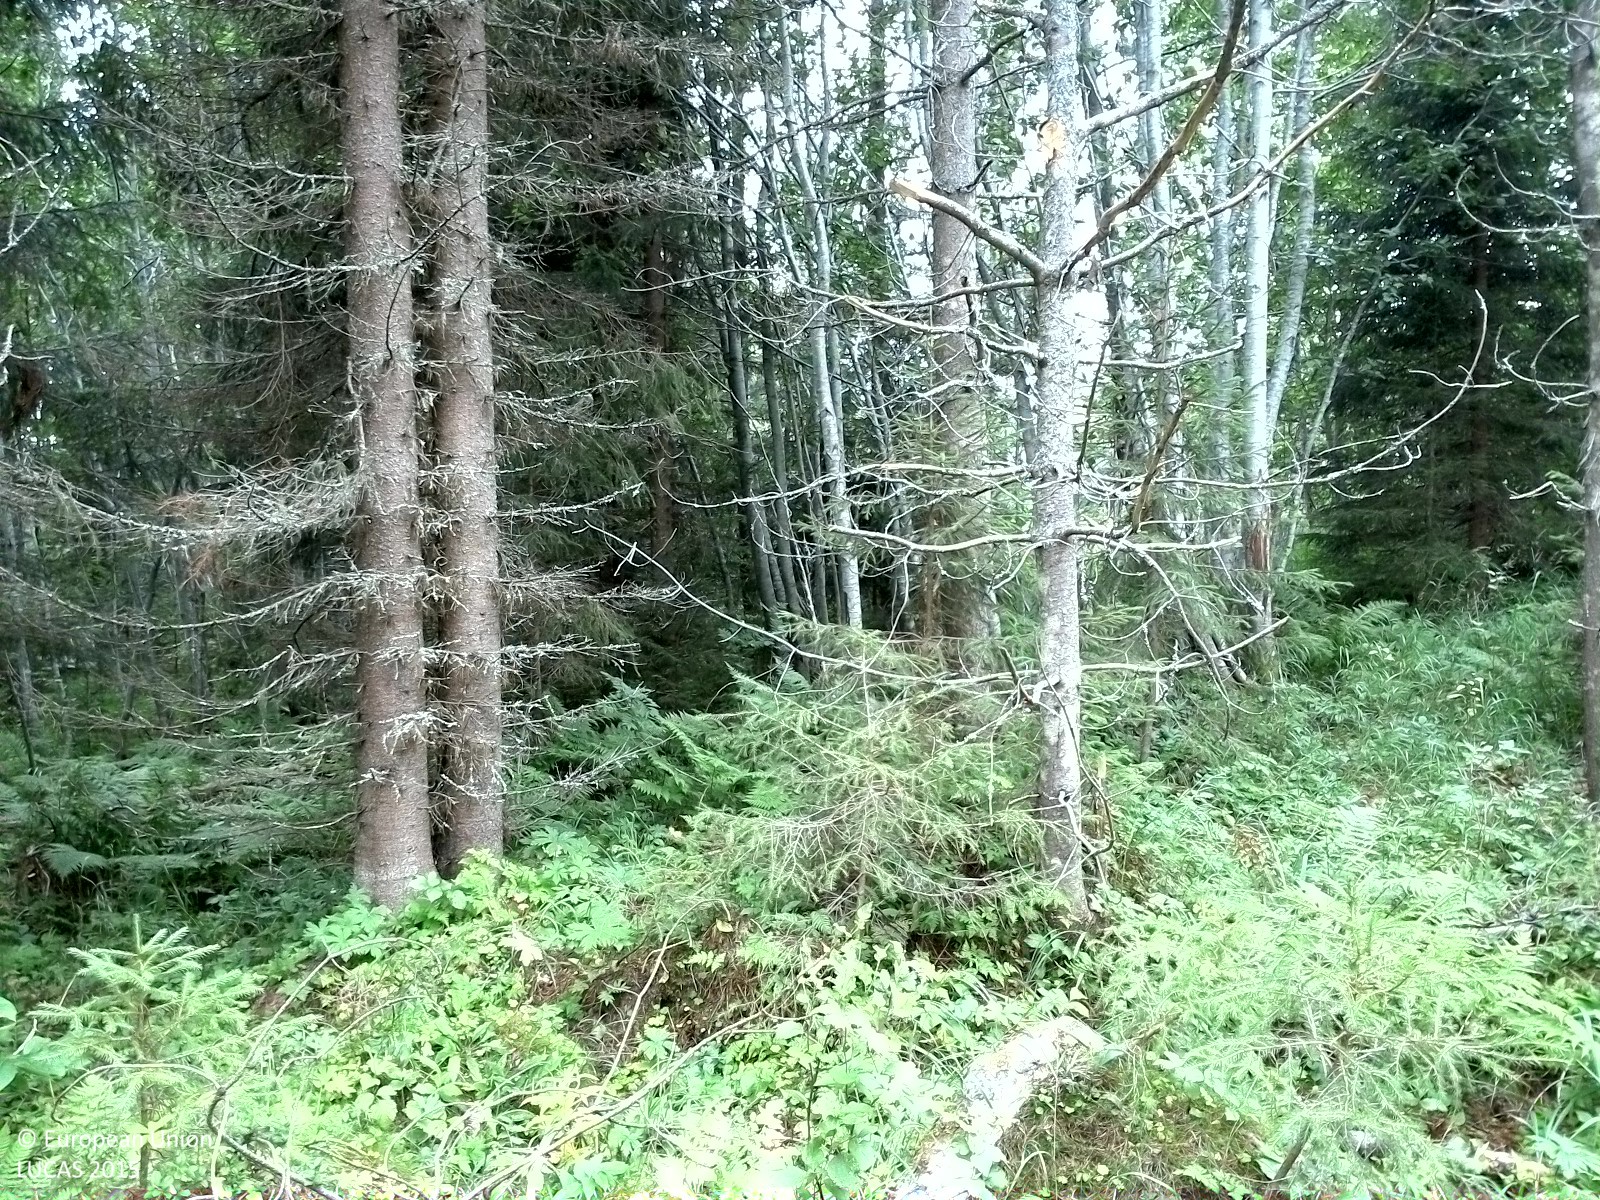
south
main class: Woodland
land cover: Pine dominated coniferous woodland
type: exotic forest
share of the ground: 50 - 75 %
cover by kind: coniferous forest trees 60 %, herbaceous plants 30 %, lichens and mosses 10 %
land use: Forestry
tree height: > 5 m
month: August
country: SE
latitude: 62.2105
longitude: 16.2677
